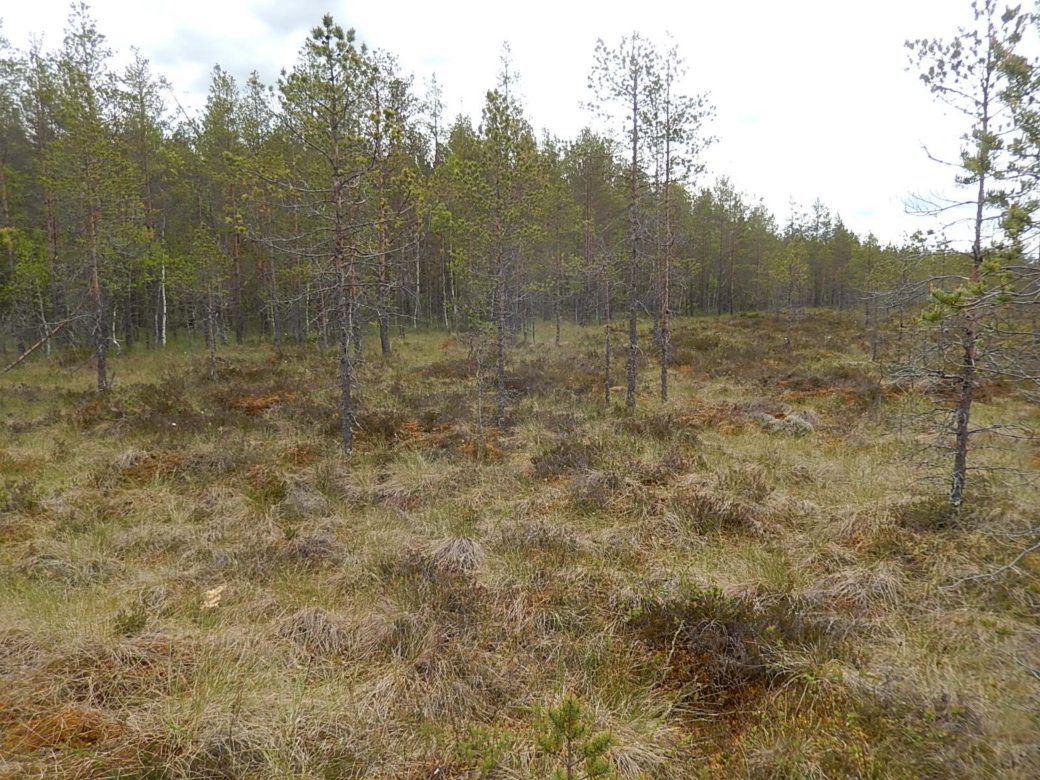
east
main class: Woodland
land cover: Pine dominated coniferous woodland
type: boreal forest
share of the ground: 50 - 75 %
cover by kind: coniferous forest trees 50 %, herbaceous plants 20 %, lichens and mosses 20 %, shrubs 10 %
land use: Forestry
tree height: > 5 m
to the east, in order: Pine dominated coniferous woodland; Ditches and canals; Pine dominated mixed woodland; Ditches and canals; Pine dominated mixed woodland; Ditches and canals; Pine dominated mixed woodland; Ditches and canals; Pine dominated mixed woodland; Ditches and canals; Pine dominated mixed woodland
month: June
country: FI
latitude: 61.9321
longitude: 22.1917
